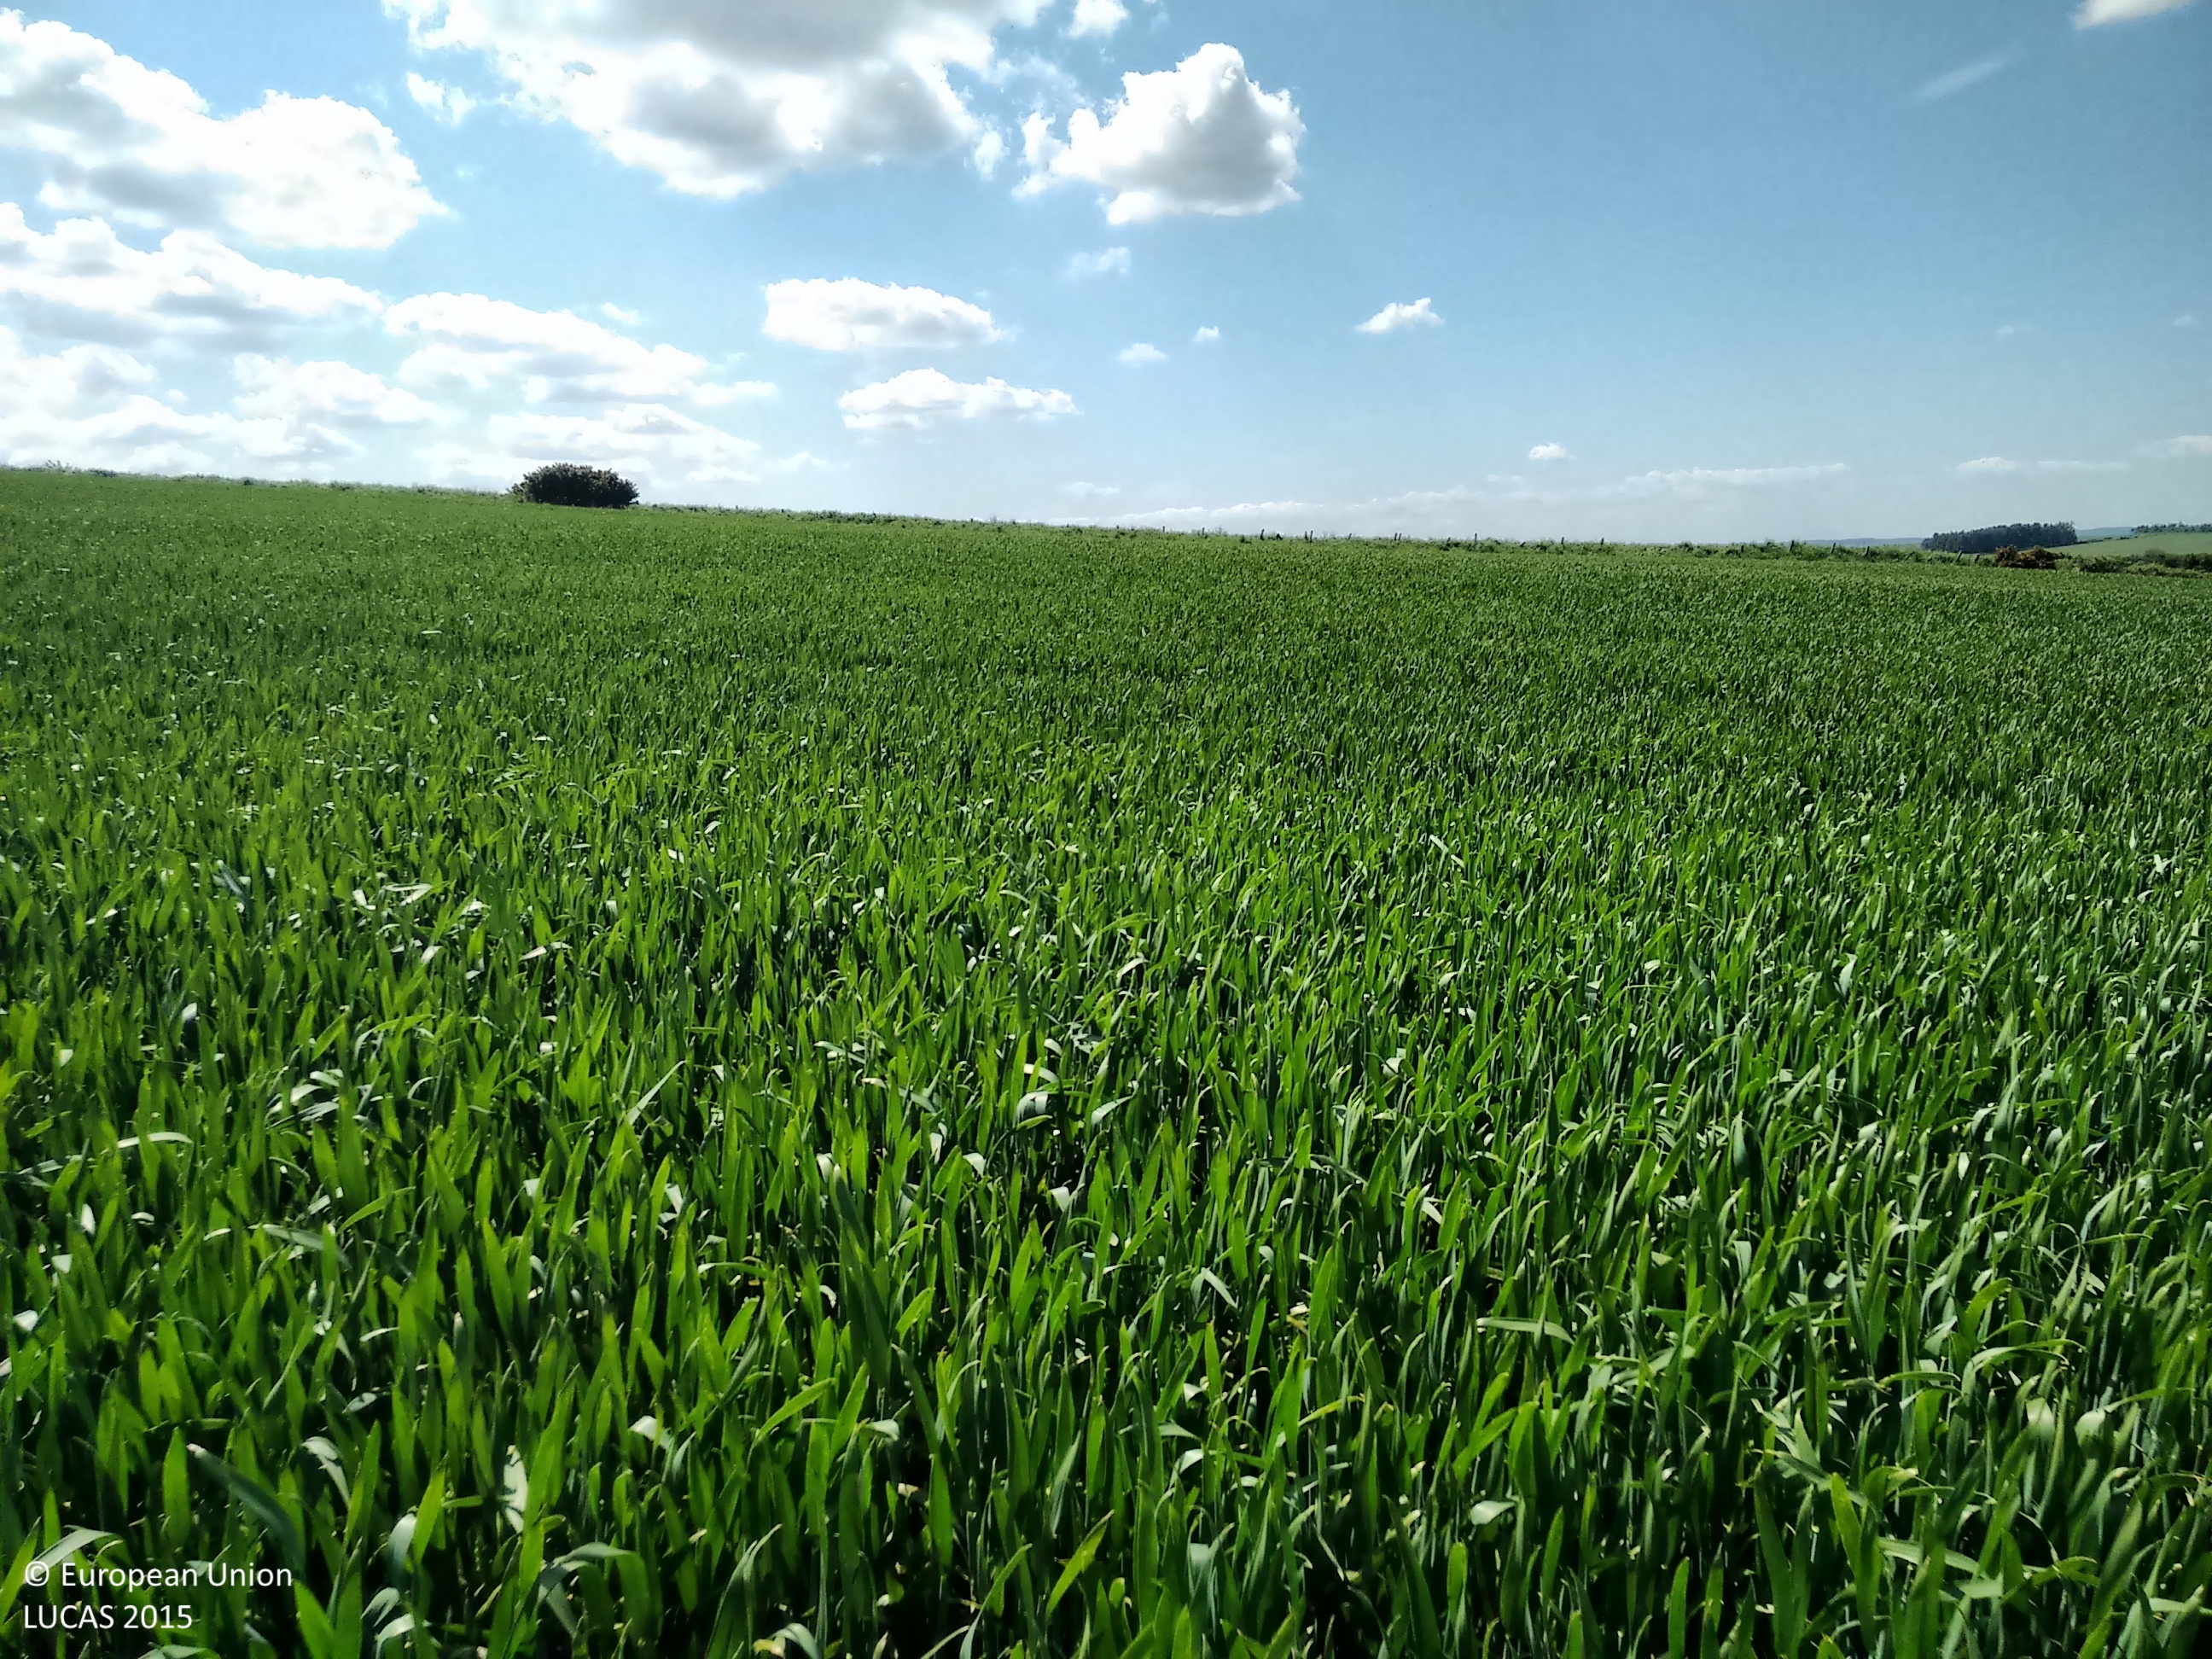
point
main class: Cropland
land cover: Common wheat
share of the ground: > 75 %
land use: Agriculture (excluding fallow land and kitchen gardens)
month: June
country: GB
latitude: 55.6683
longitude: -2.0891
